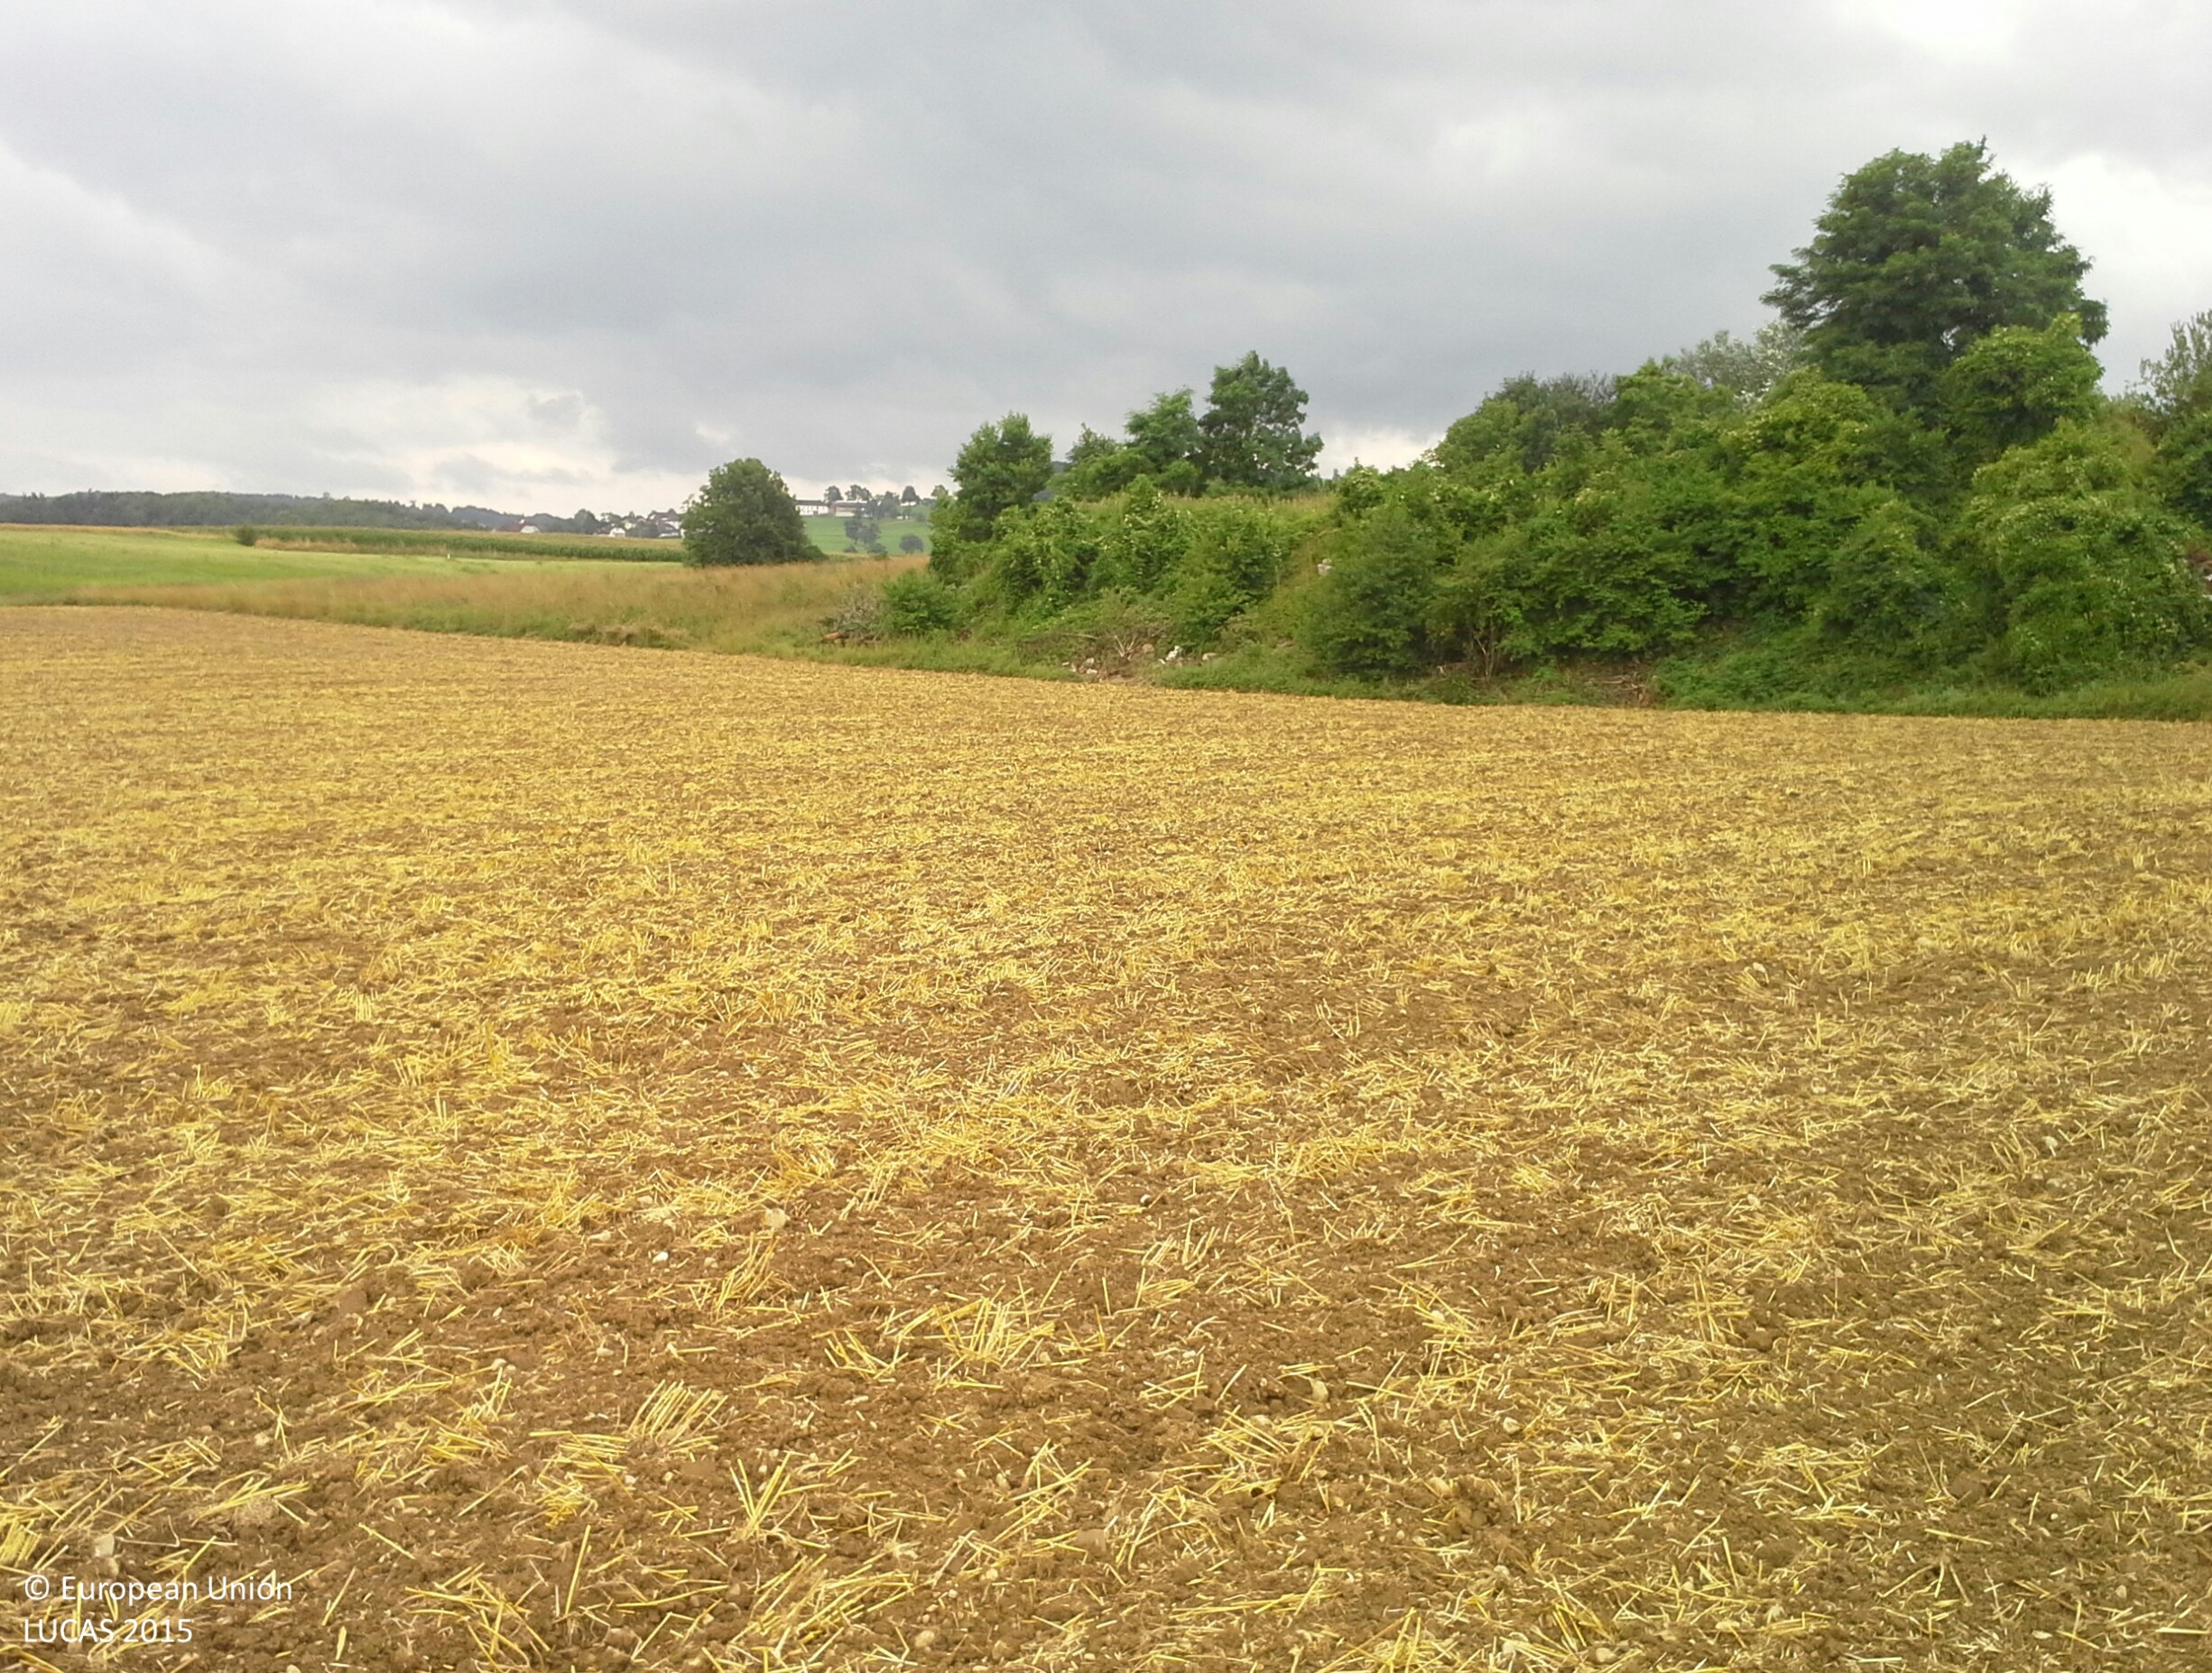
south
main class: Cropland
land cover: Barley
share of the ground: 10 - 25 %
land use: Agriculture (excluding fallow land and kitchen gardens)
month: July
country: AT
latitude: 48.0630
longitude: 14.8449
